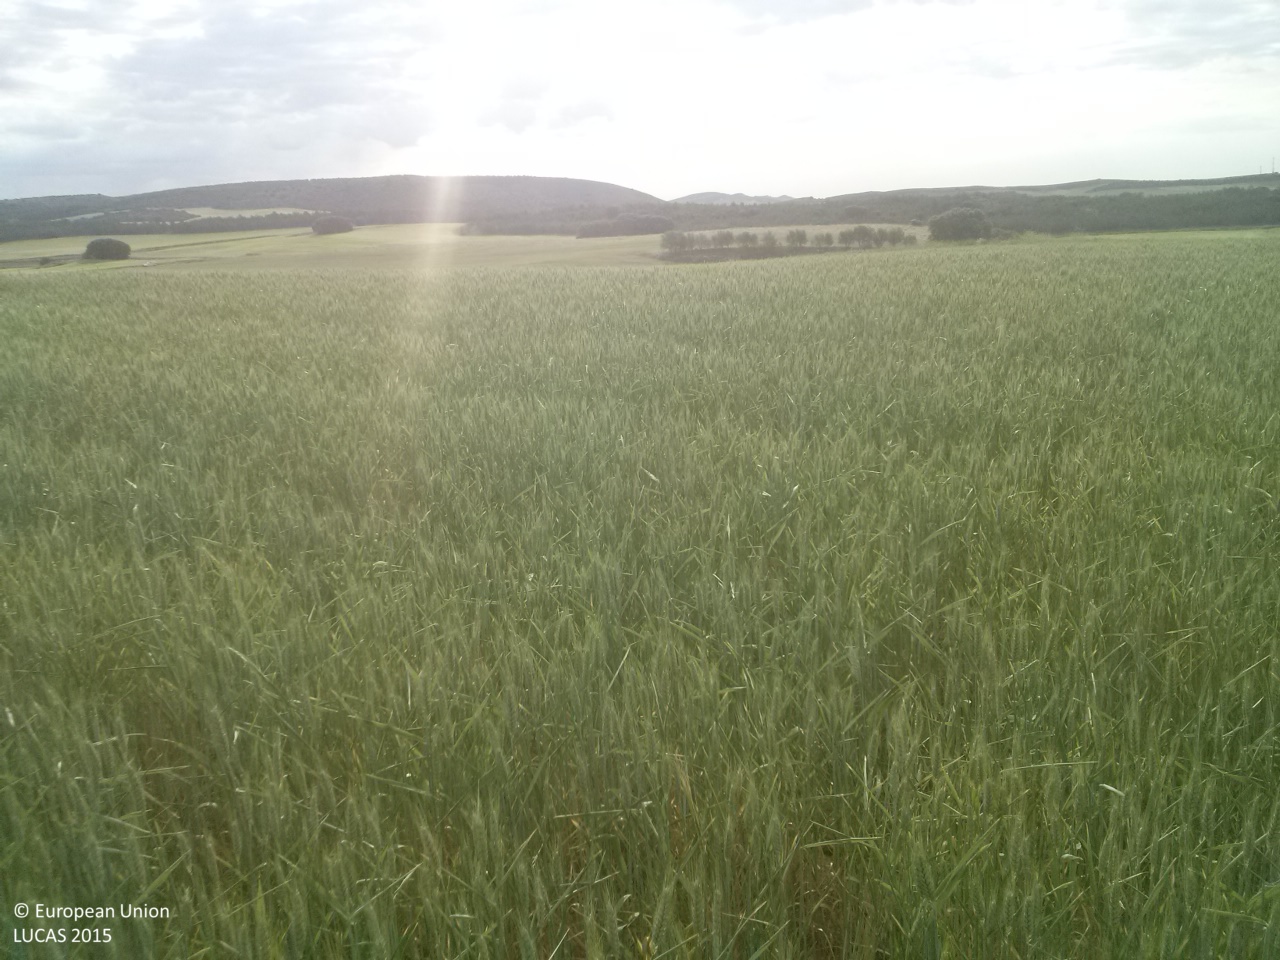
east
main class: Cropland
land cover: Common wheat
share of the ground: > 75 %
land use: Agriculture (excluding fallow land and kitchen gardens)
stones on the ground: < 10 %
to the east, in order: Common wheat; Grass margins; Common wheat; Grass margins; Groves; Grass margins; Common wheat
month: May
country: ES
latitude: 40.0754
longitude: -2.8632
